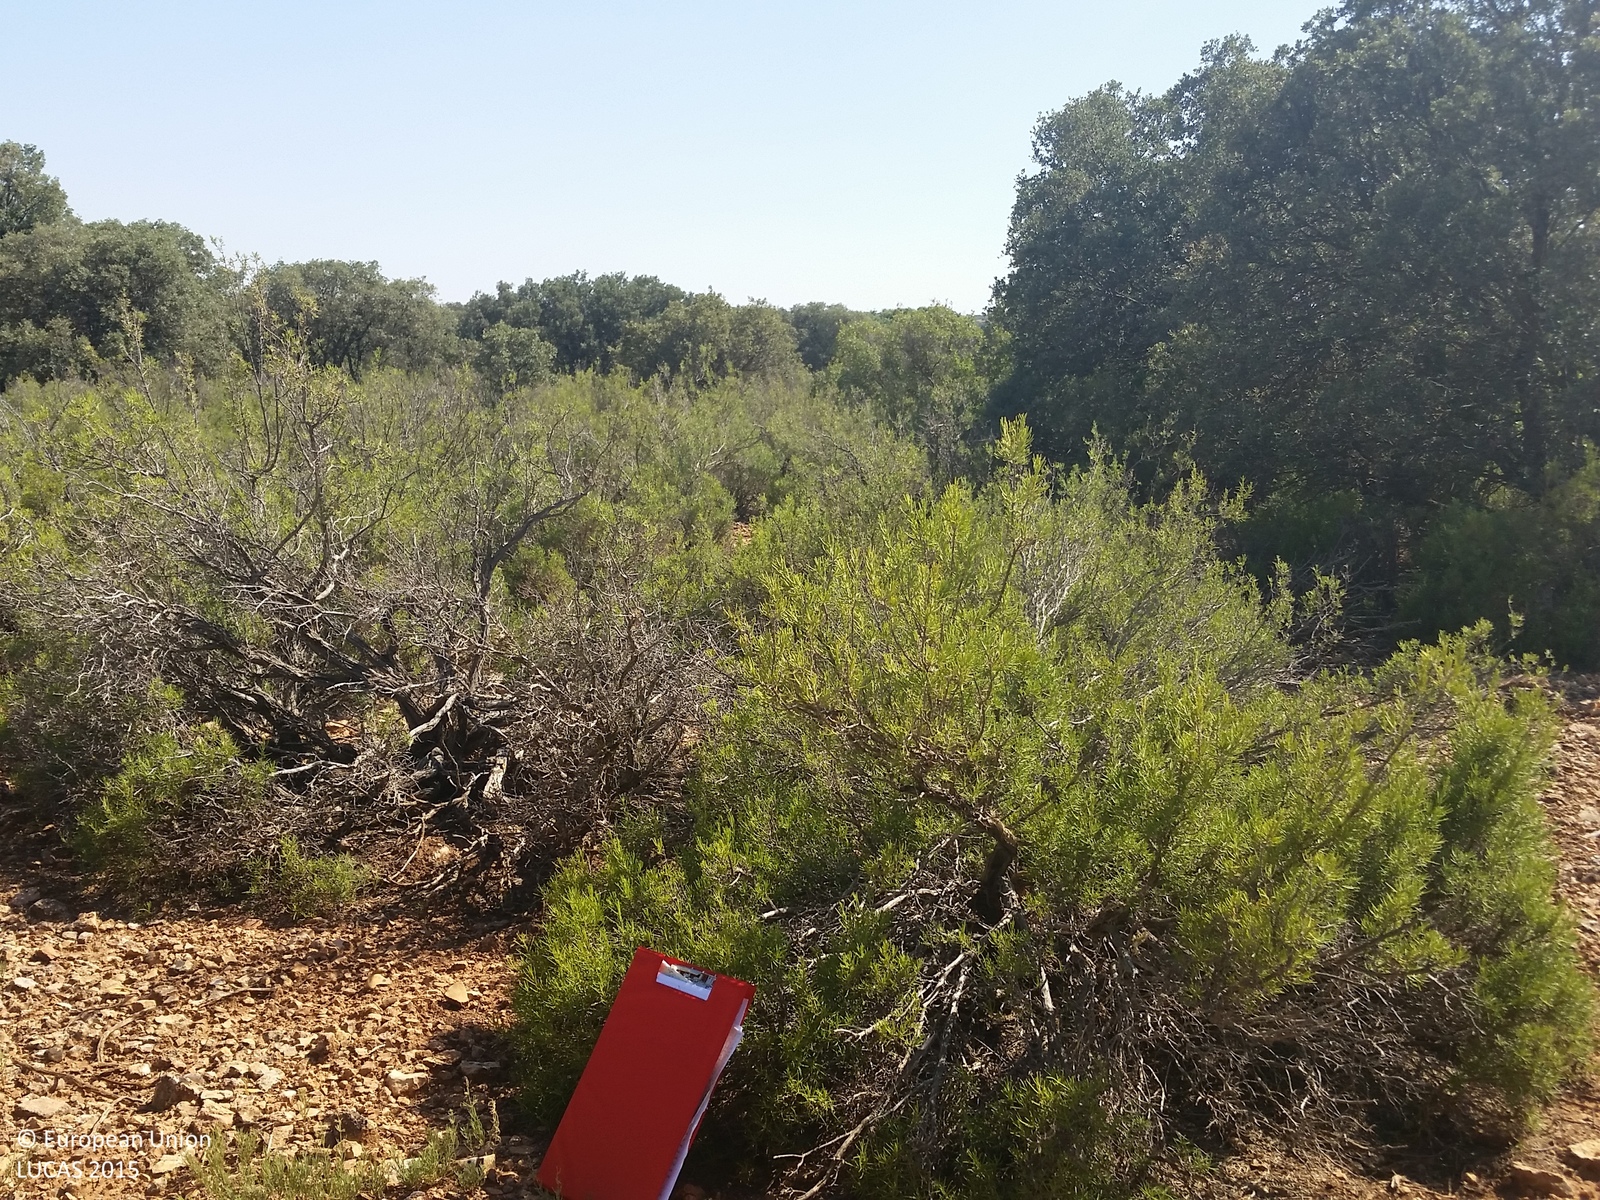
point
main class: Woodland
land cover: Broadleaved woodland
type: broadleaved evergreen forest
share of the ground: 50 - 75 %
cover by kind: broadleaved forest trees 50 %, shrubs 35 %, consolidated bare surface 10 %, herbaceous plants 5 %
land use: Semi-natural and natural areas not in use
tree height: < 5 m
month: July
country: ES
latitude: 39.0800
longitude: -2.5028
